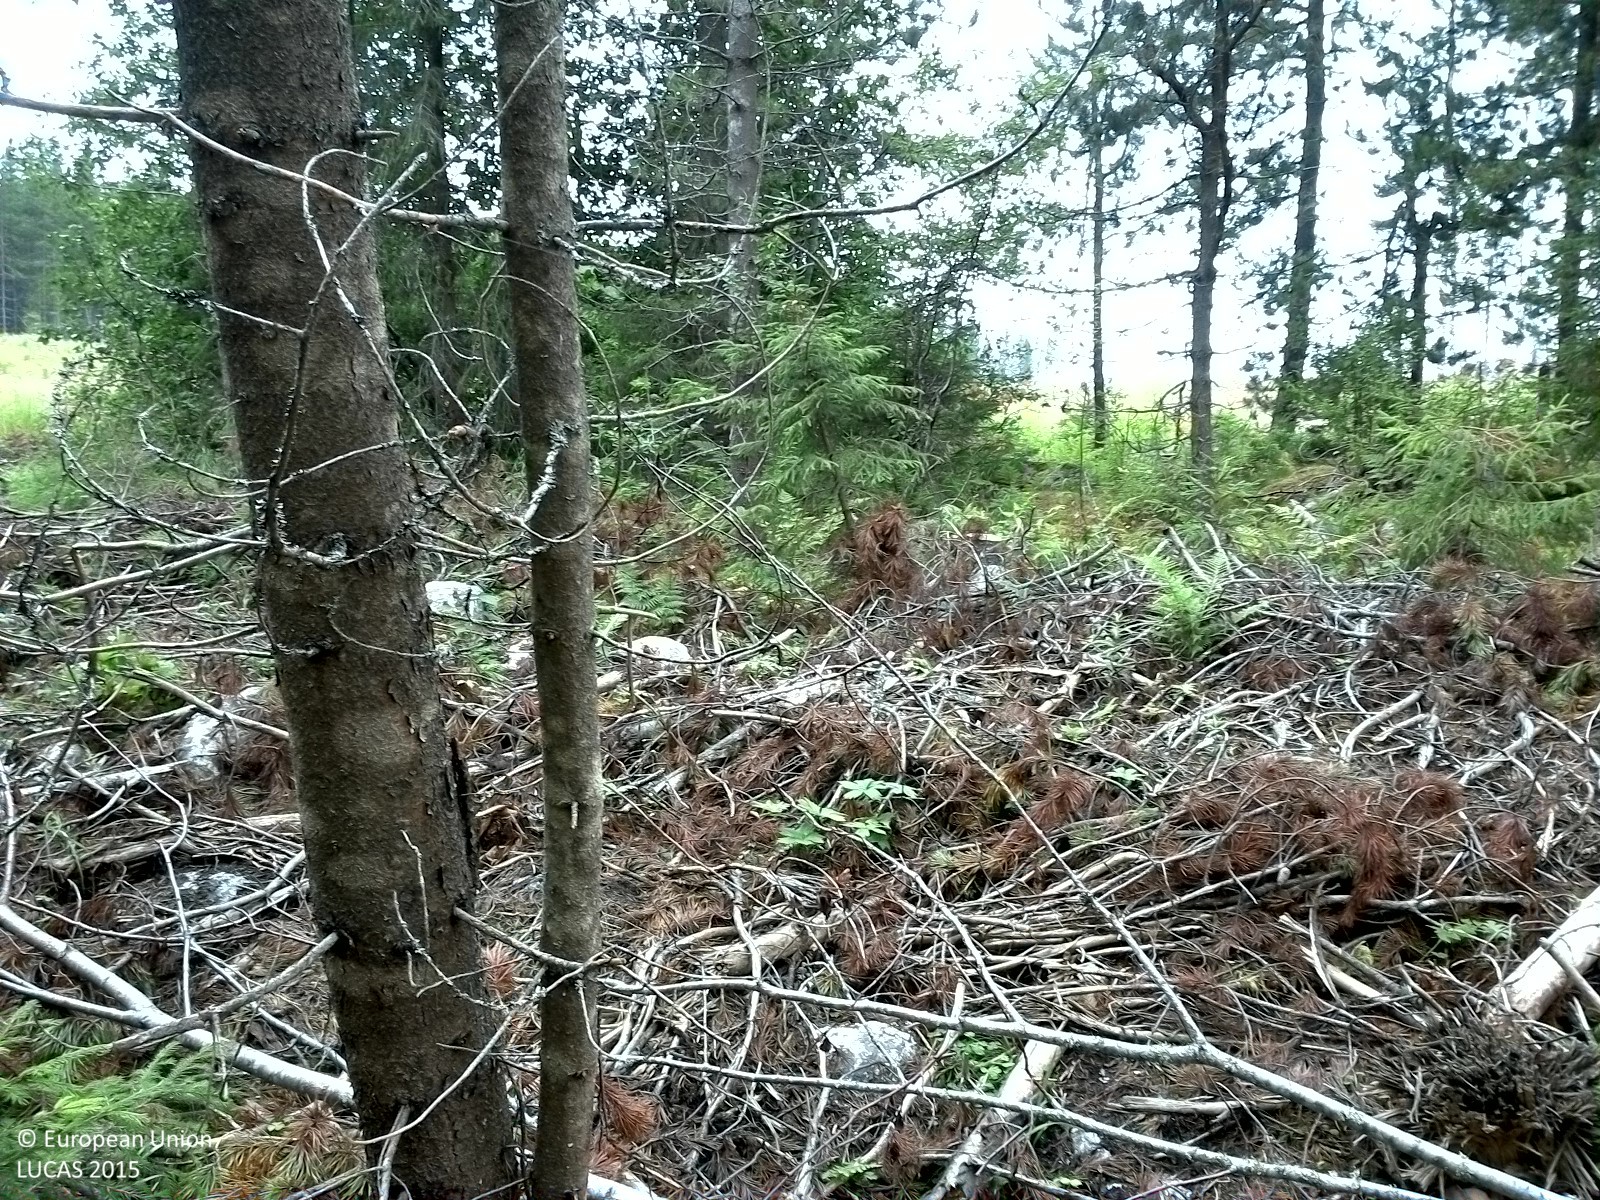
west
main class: Woodland
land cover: Pine dominated coniferous woodland
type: exotic forest
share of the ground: 50 - 75 %
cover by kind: coniferous forest trees 60 %, herbaceous plants 30 %, lichens and mosses 10 %
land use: Forestry
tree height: > 5 m
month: August
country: SE
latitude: 62.2105
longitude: 16.2677
